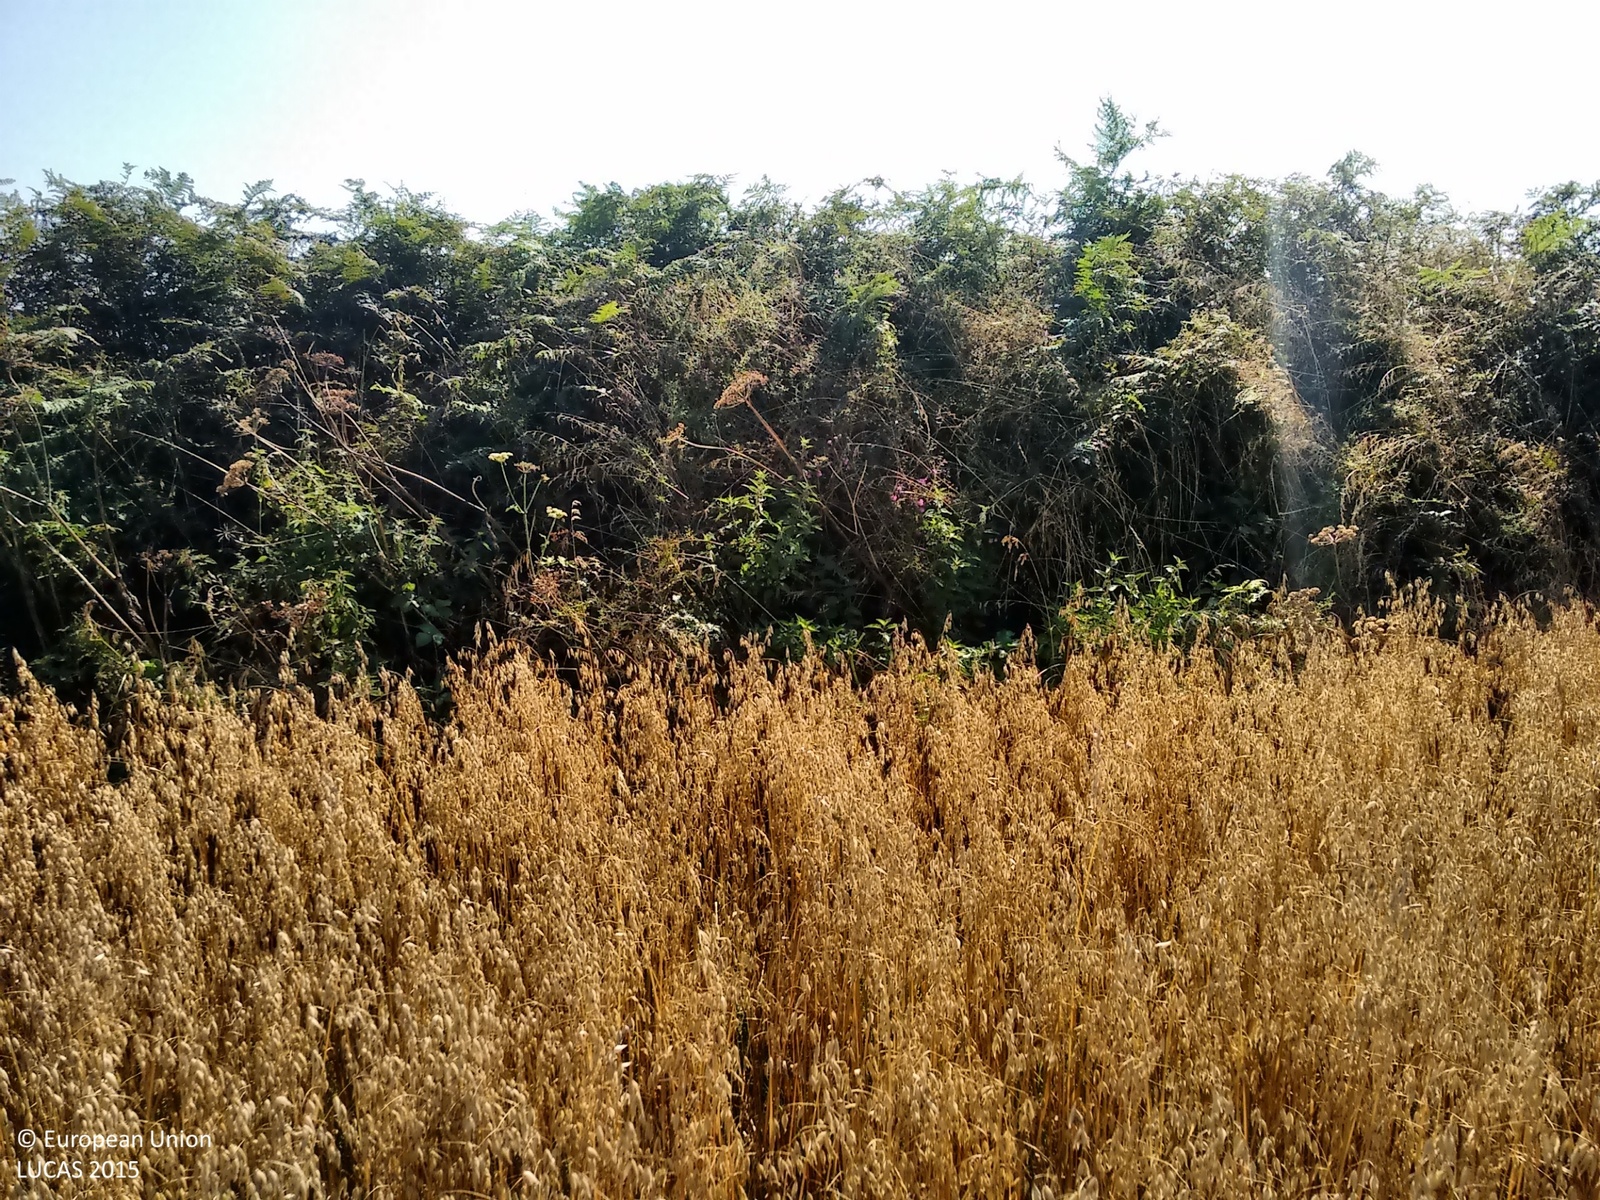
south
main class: Cropland
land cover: Oats
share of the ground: > 75 %
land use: Agriculture (excluding fallow land and kitchen gardens)
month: September
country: GB
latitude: 50.9933
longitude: -4.4513
